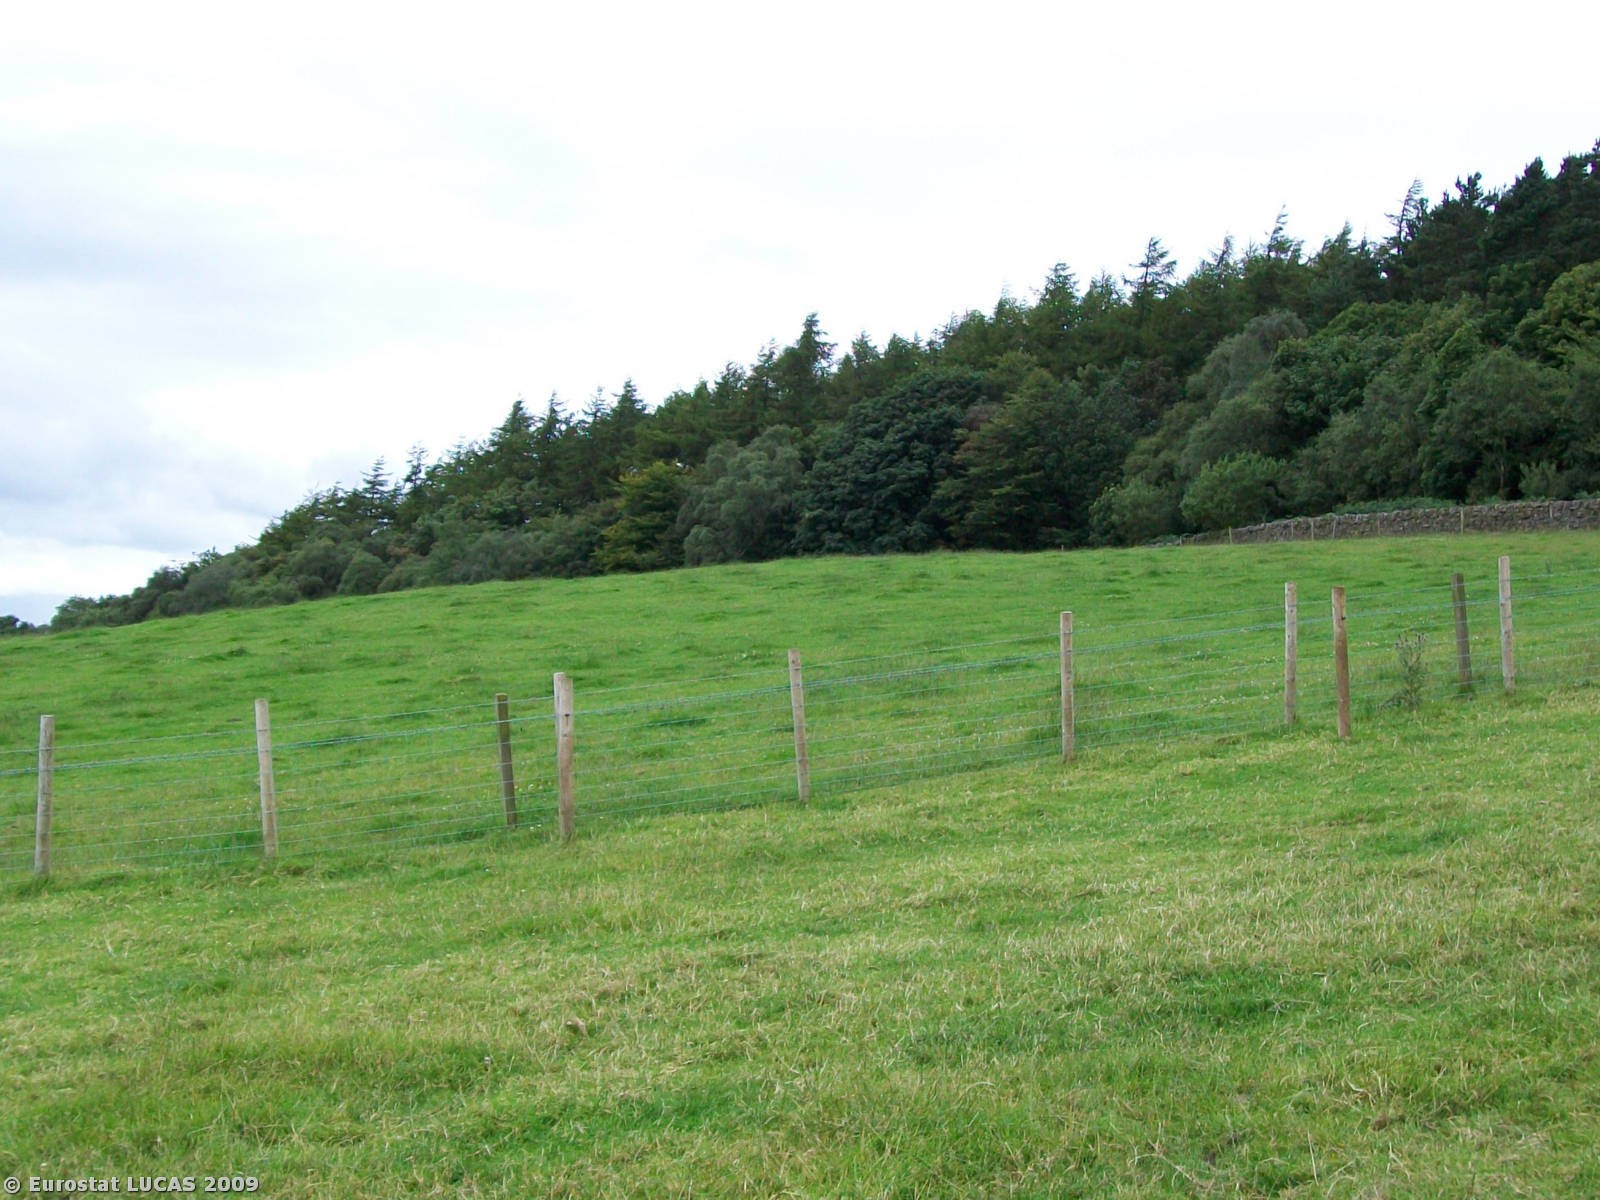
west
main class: Grassland
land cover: Grassland without tree/shrub cover
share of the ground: > 75 %
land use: Agriculture (excluding fallow land and kitchen gardens)
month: July
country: GB
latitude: 55.0353
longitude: -3.2981
